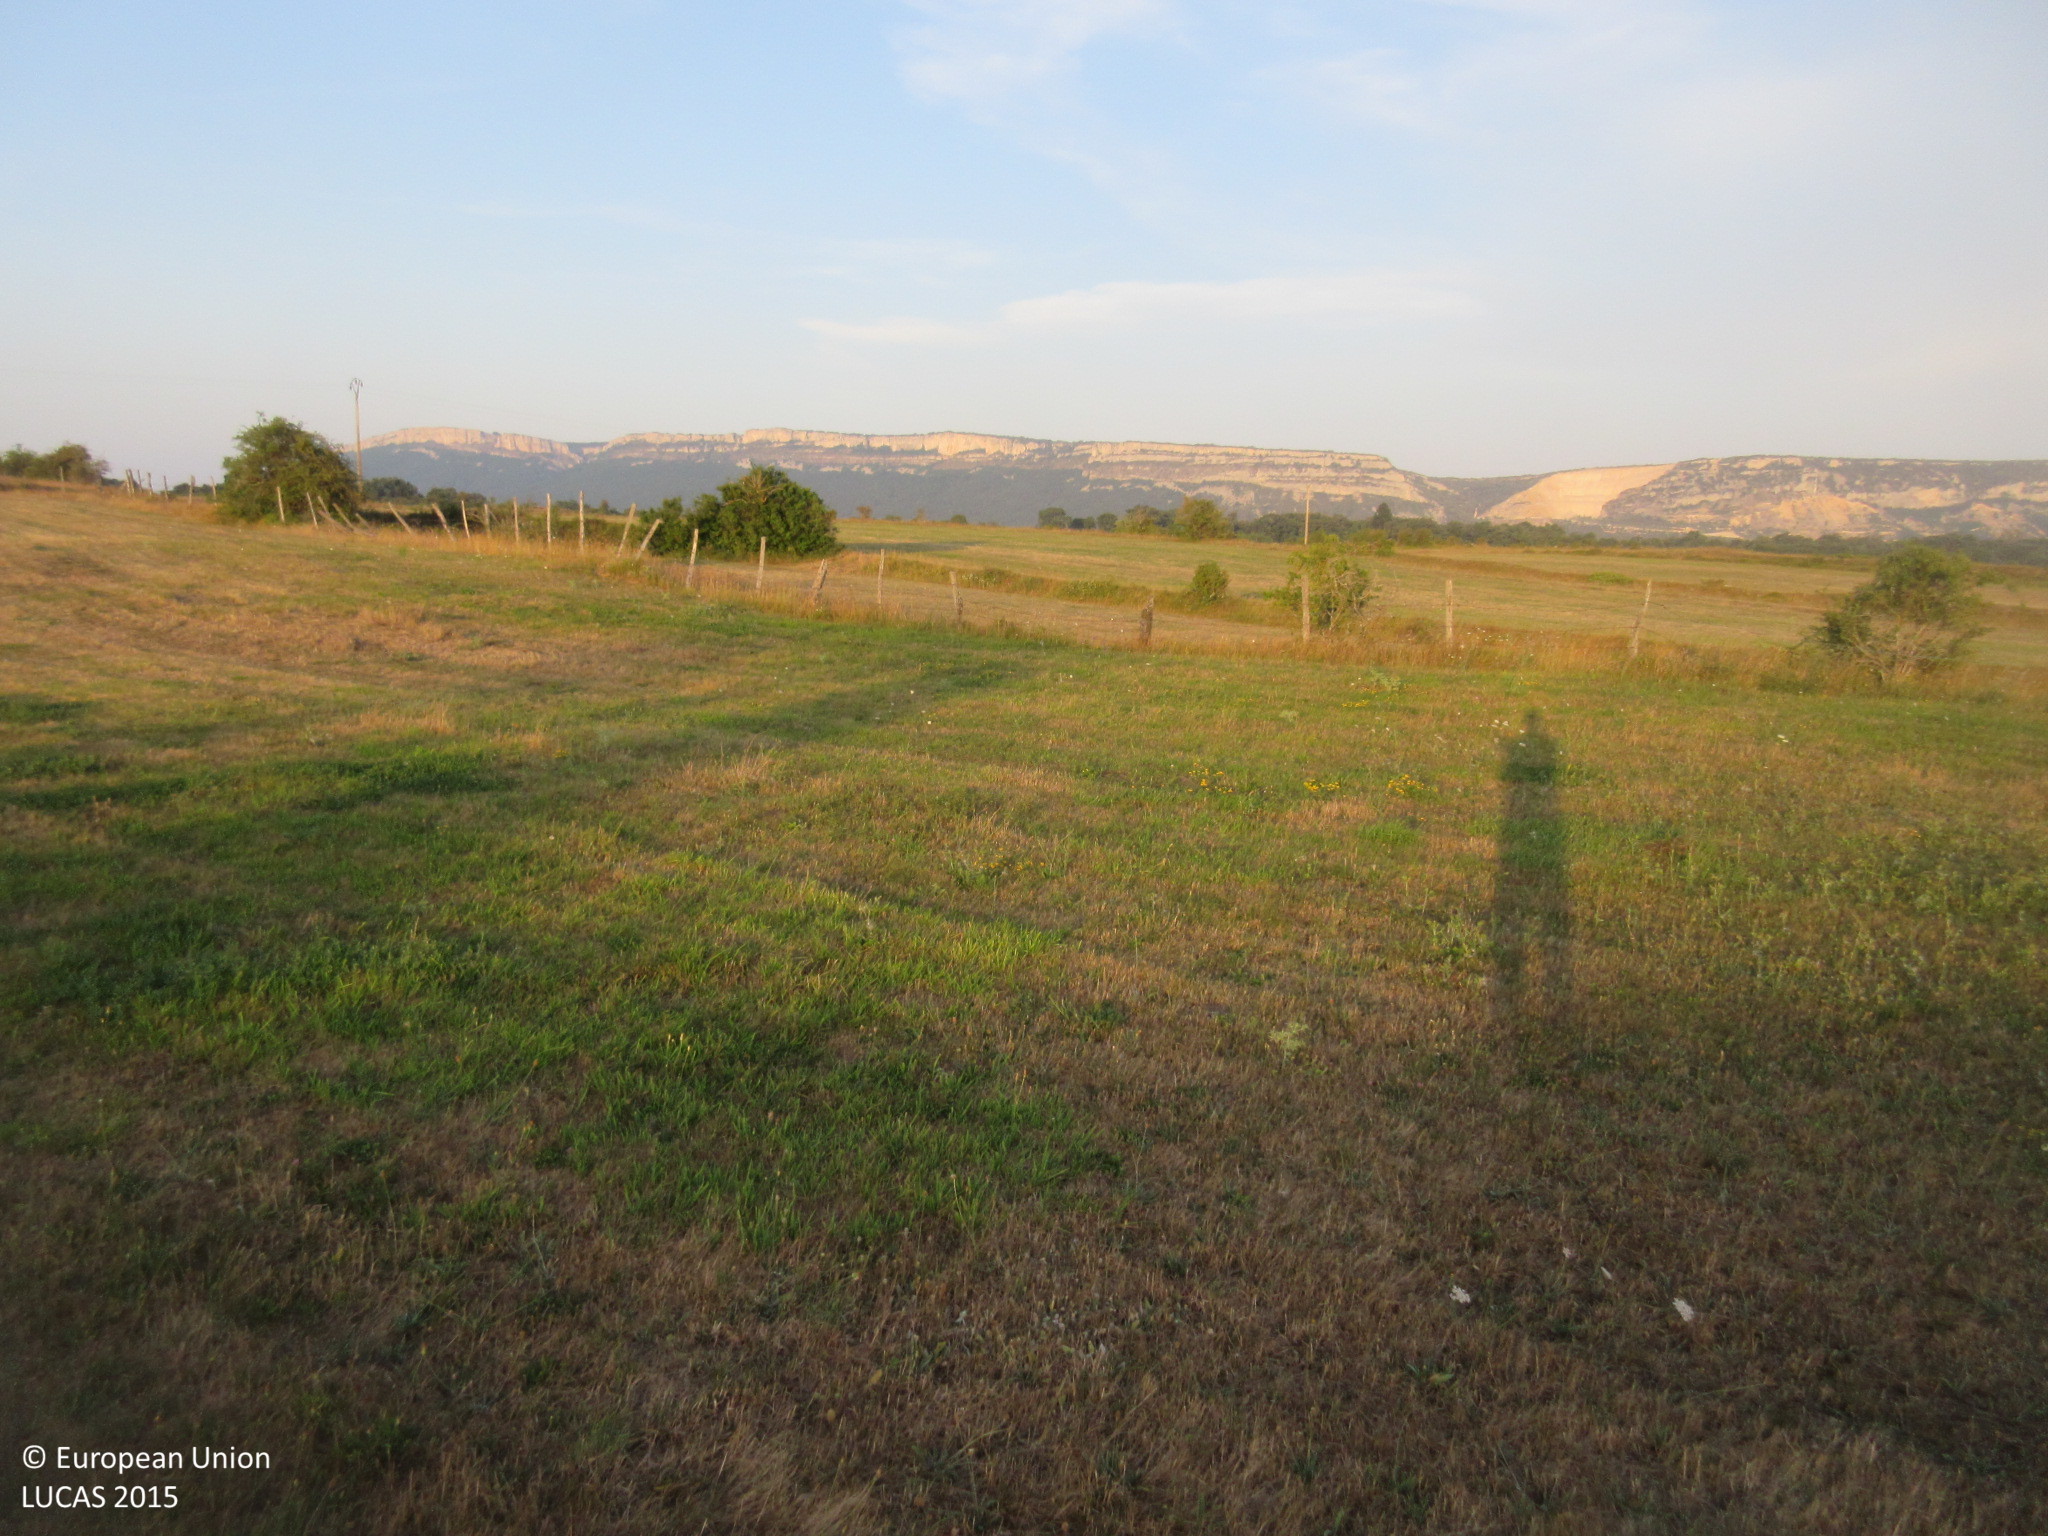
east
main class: Grassland
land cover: Grassland without tree/shrub cover
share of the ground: > 75 %
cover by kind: herbaceous plants 100 %
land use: Agriculture (excluding fallow land and kitchen gardens)
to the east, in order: Grassland without tree/shrub cover; Fences; Grassland without tree/shrub cover; Abandoned hedges; Grassland without tree/shrub cover; Tracks; Grassland without tree/shrub cover; Single bushes/trees; Grassland without tree/shrub cover
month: July
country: ES
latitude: 43.0604
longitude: -3.5104
